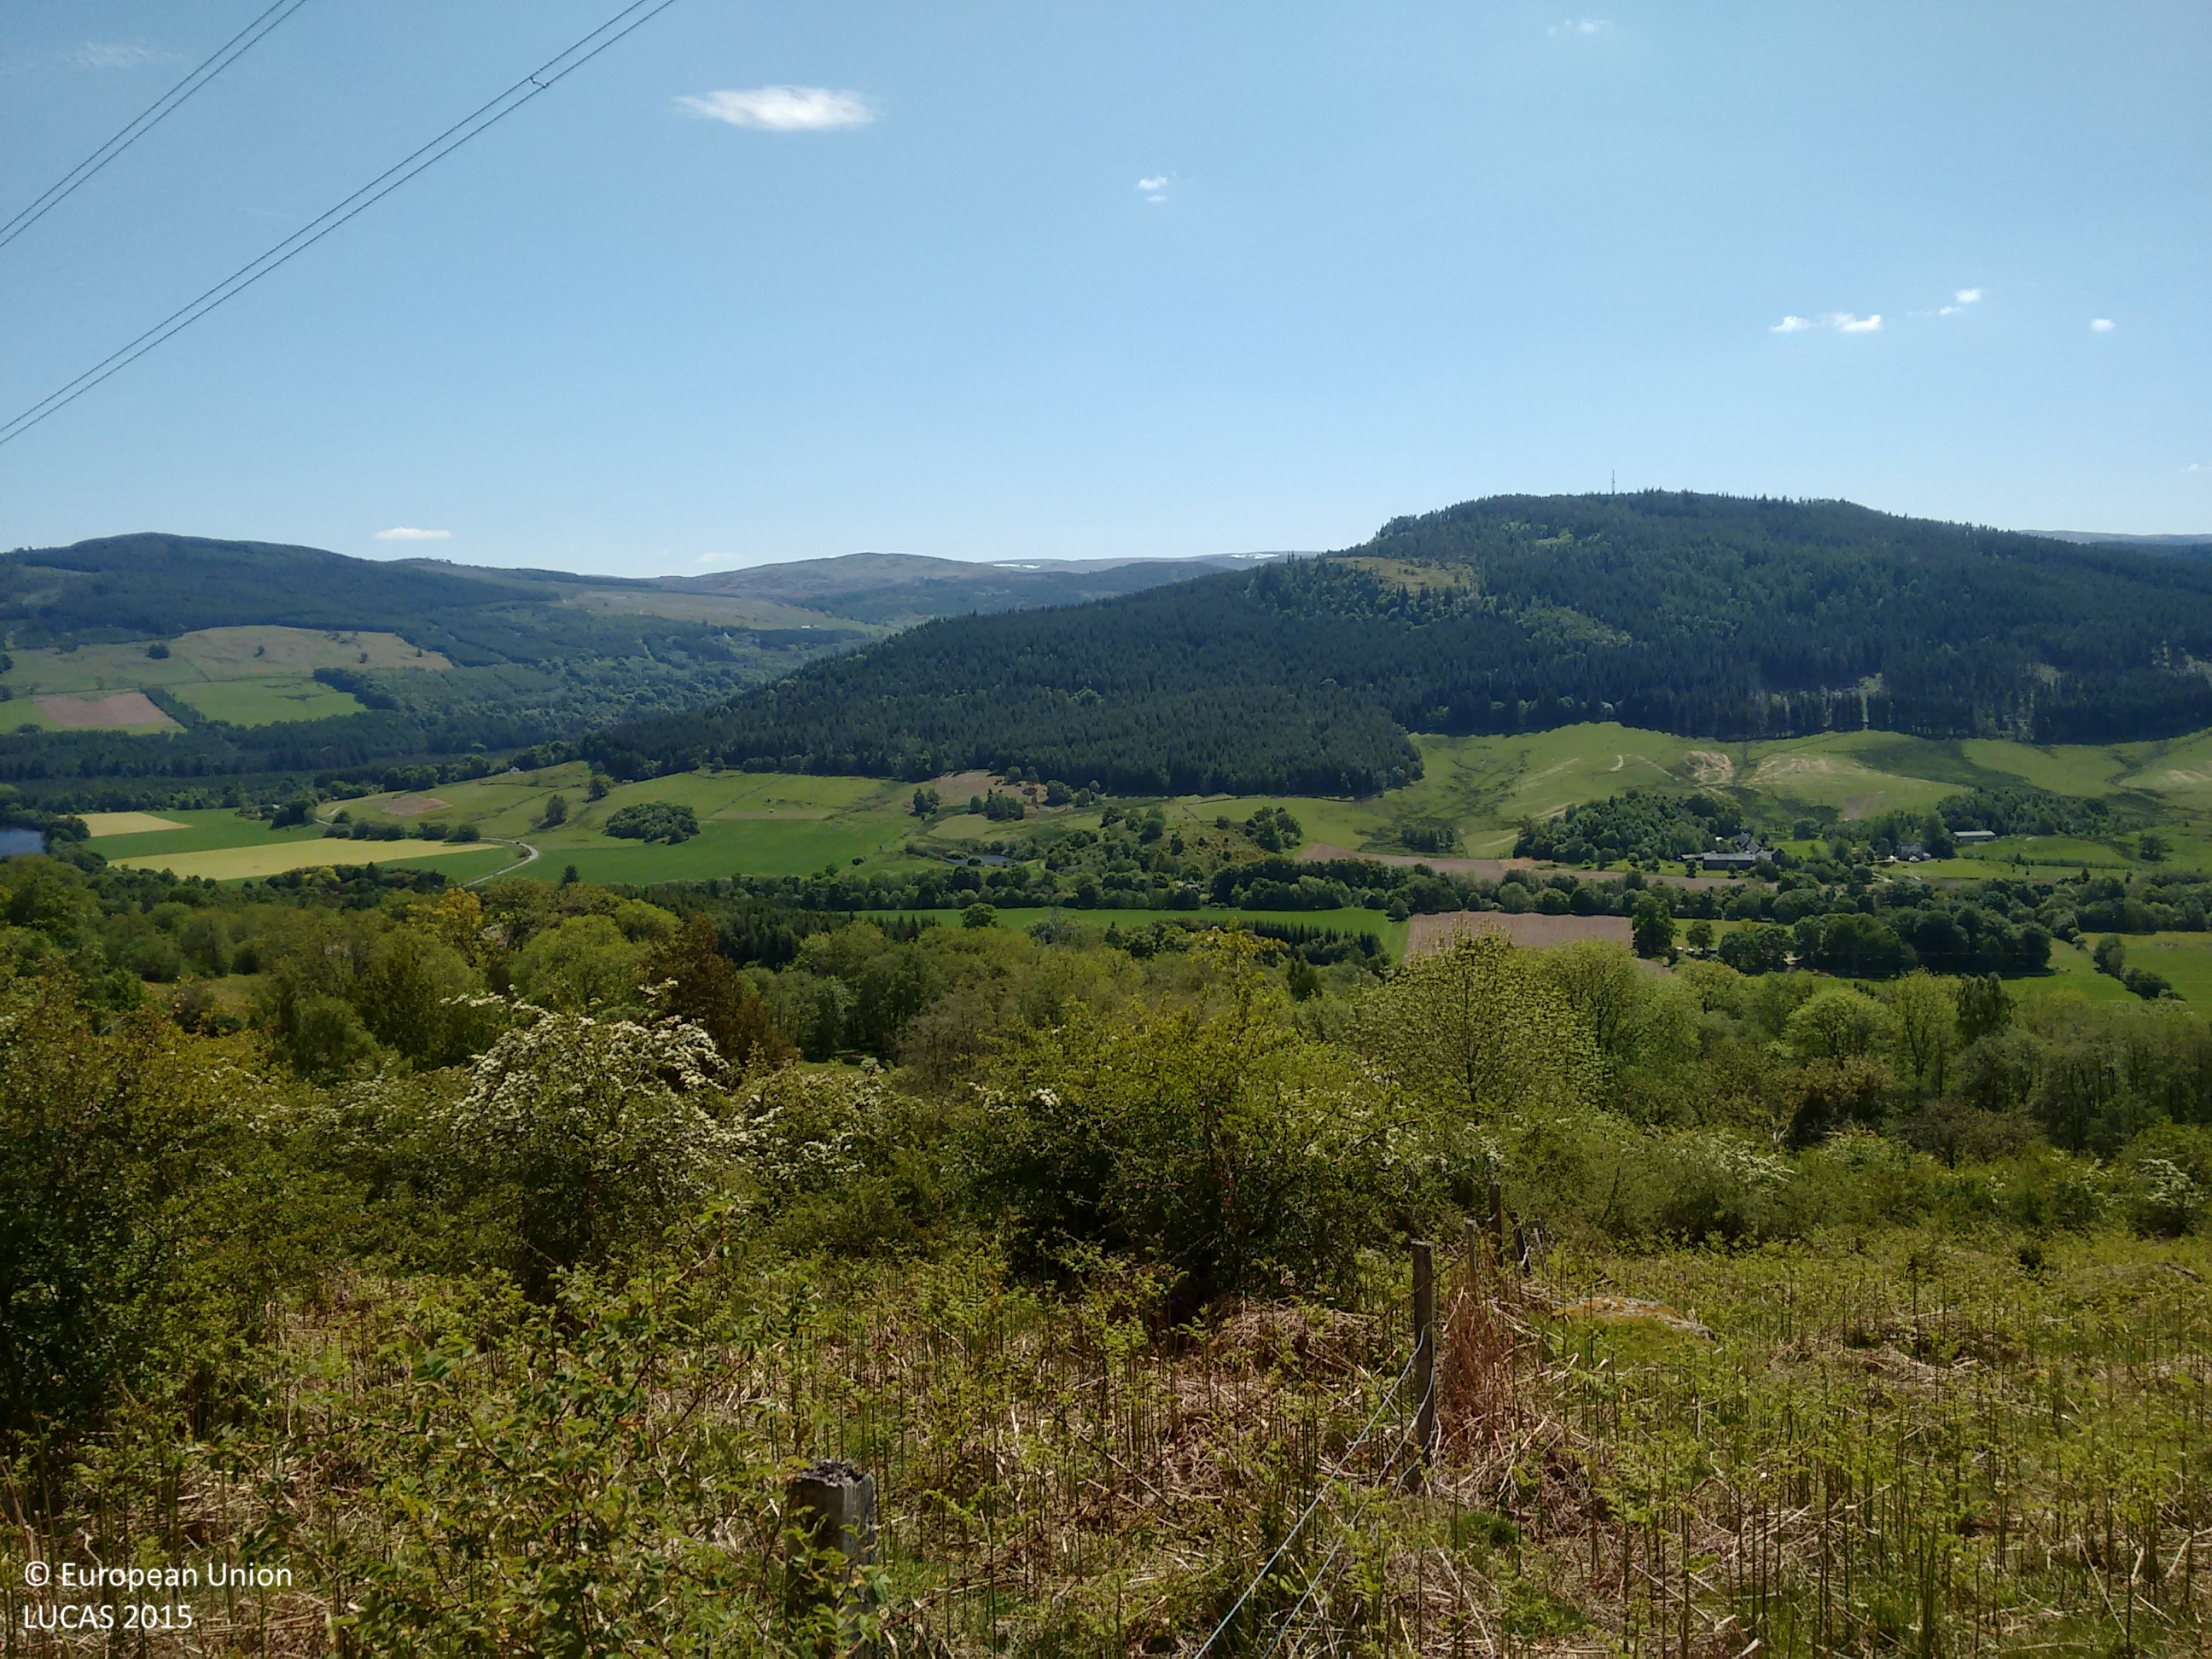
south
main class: Shrubland
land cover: Shrubland without tree cover
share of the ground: > 75 %
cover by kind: shrubs 70 %, herbaceous plants 30 %
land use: Agriculture (excluding fallow land and kitchen gardens)
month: June
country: GB
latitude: 56.6232
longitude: -3.9867
